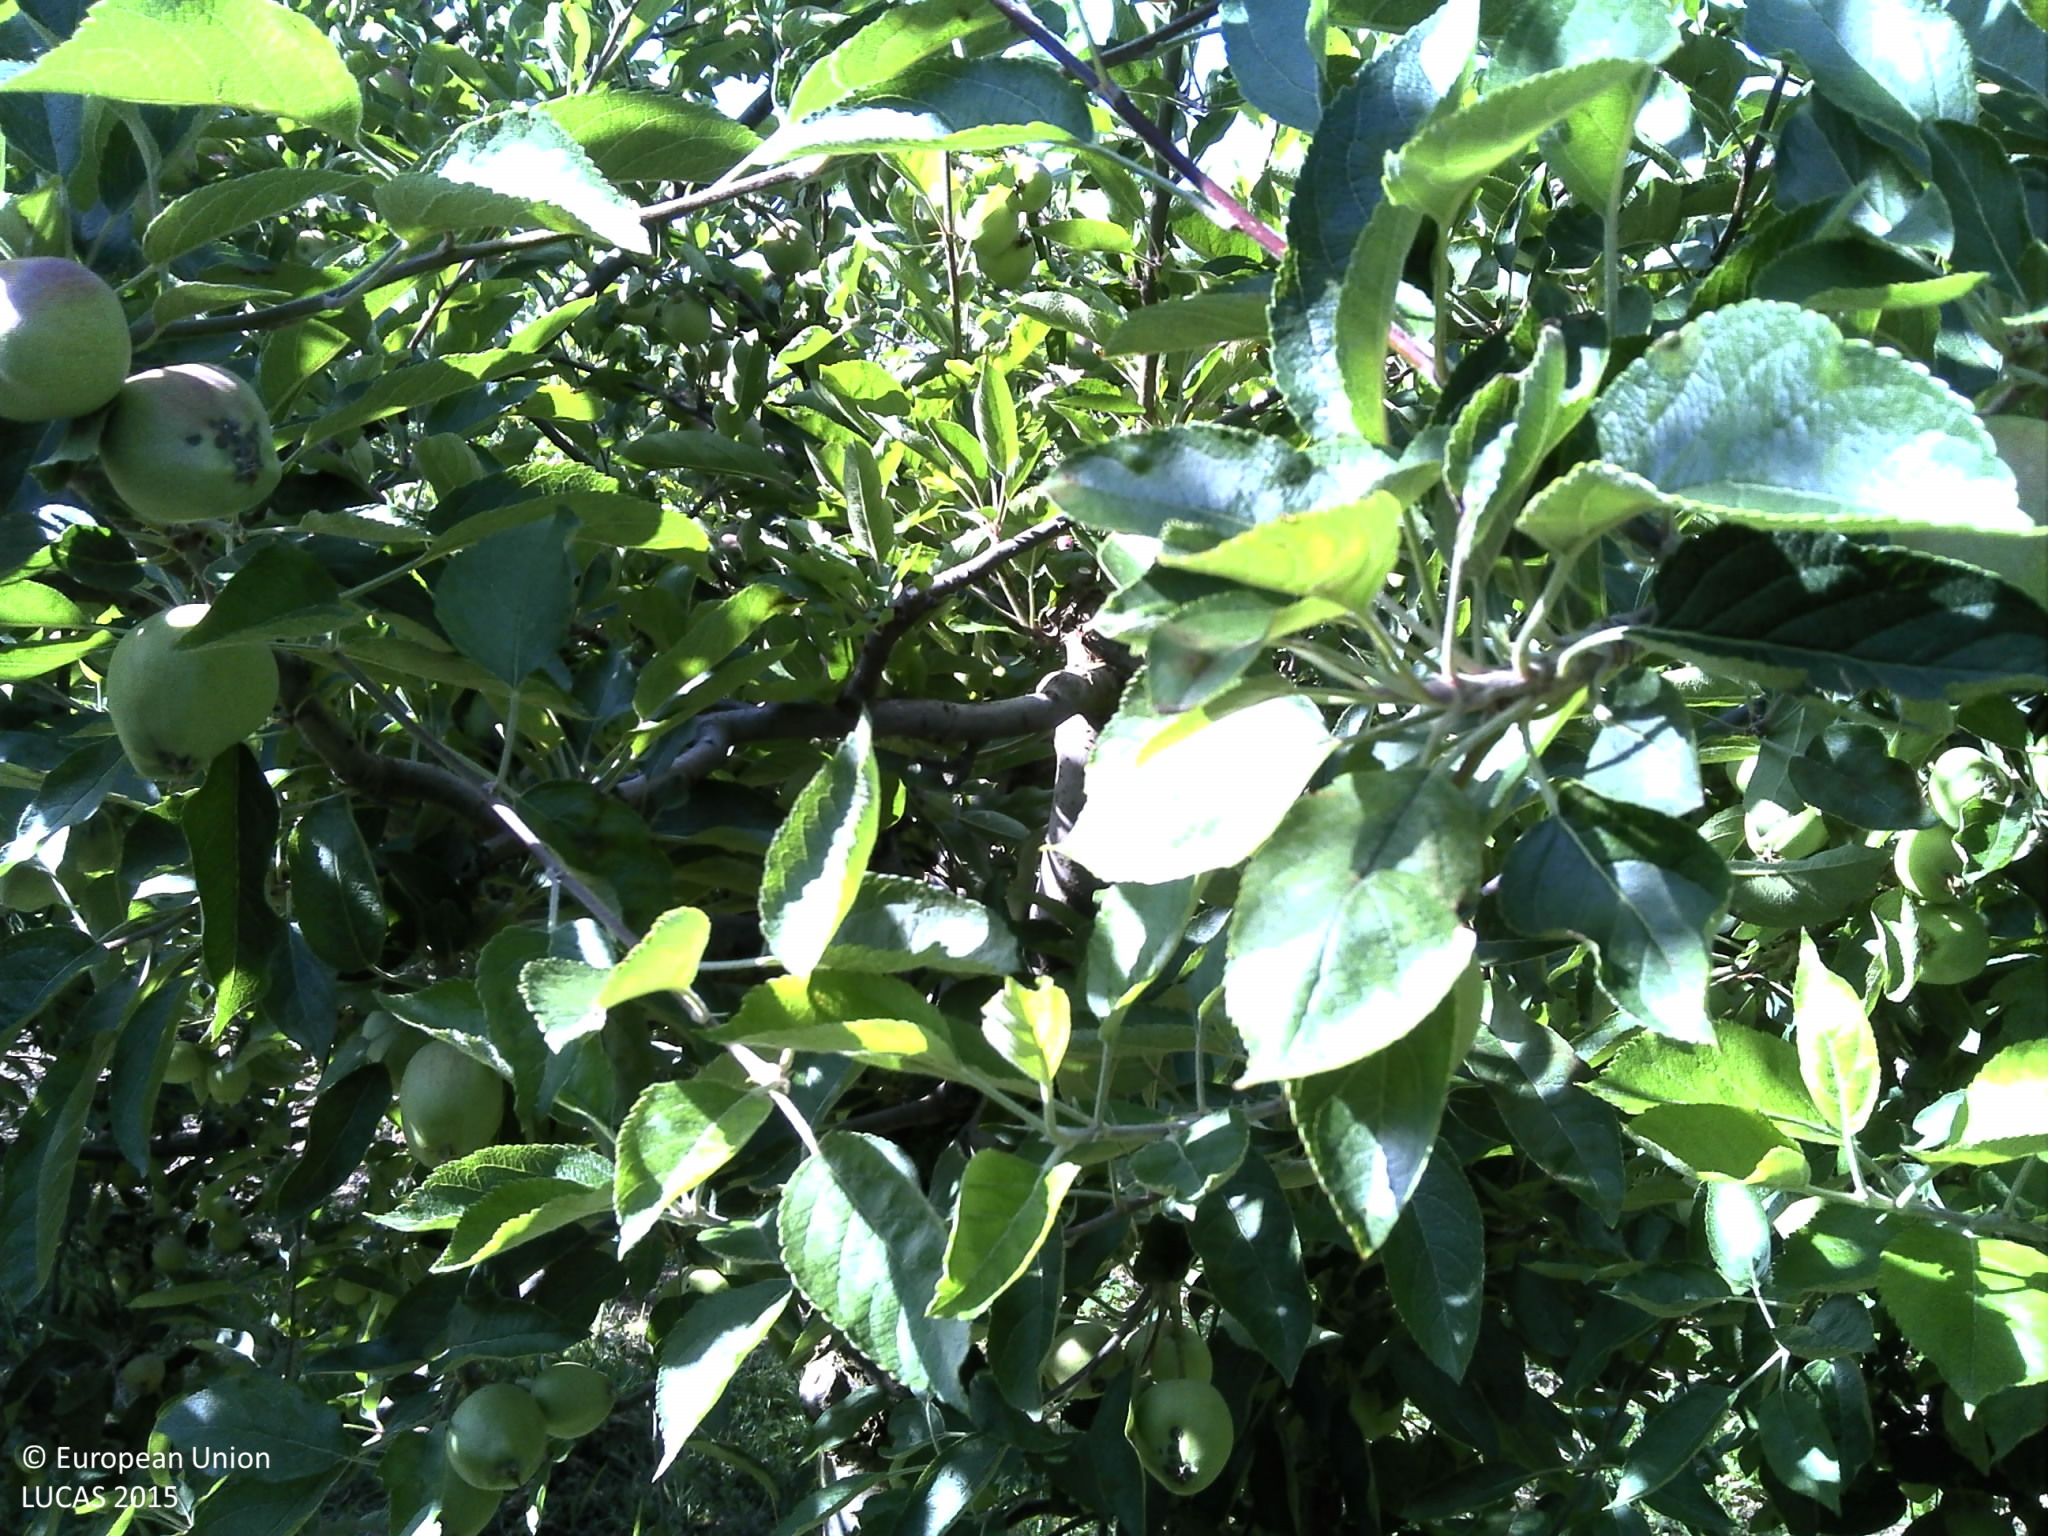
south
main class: Cropland
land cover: Apple fruit
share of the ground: 50 - 75 %
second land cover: Grassland without tree/shrub cover
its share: 25 - 50 %
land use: Agriculture (excluding fallow land and kitchen gardens)
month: June
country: PT
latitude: 40.9950
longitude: -7.5598
